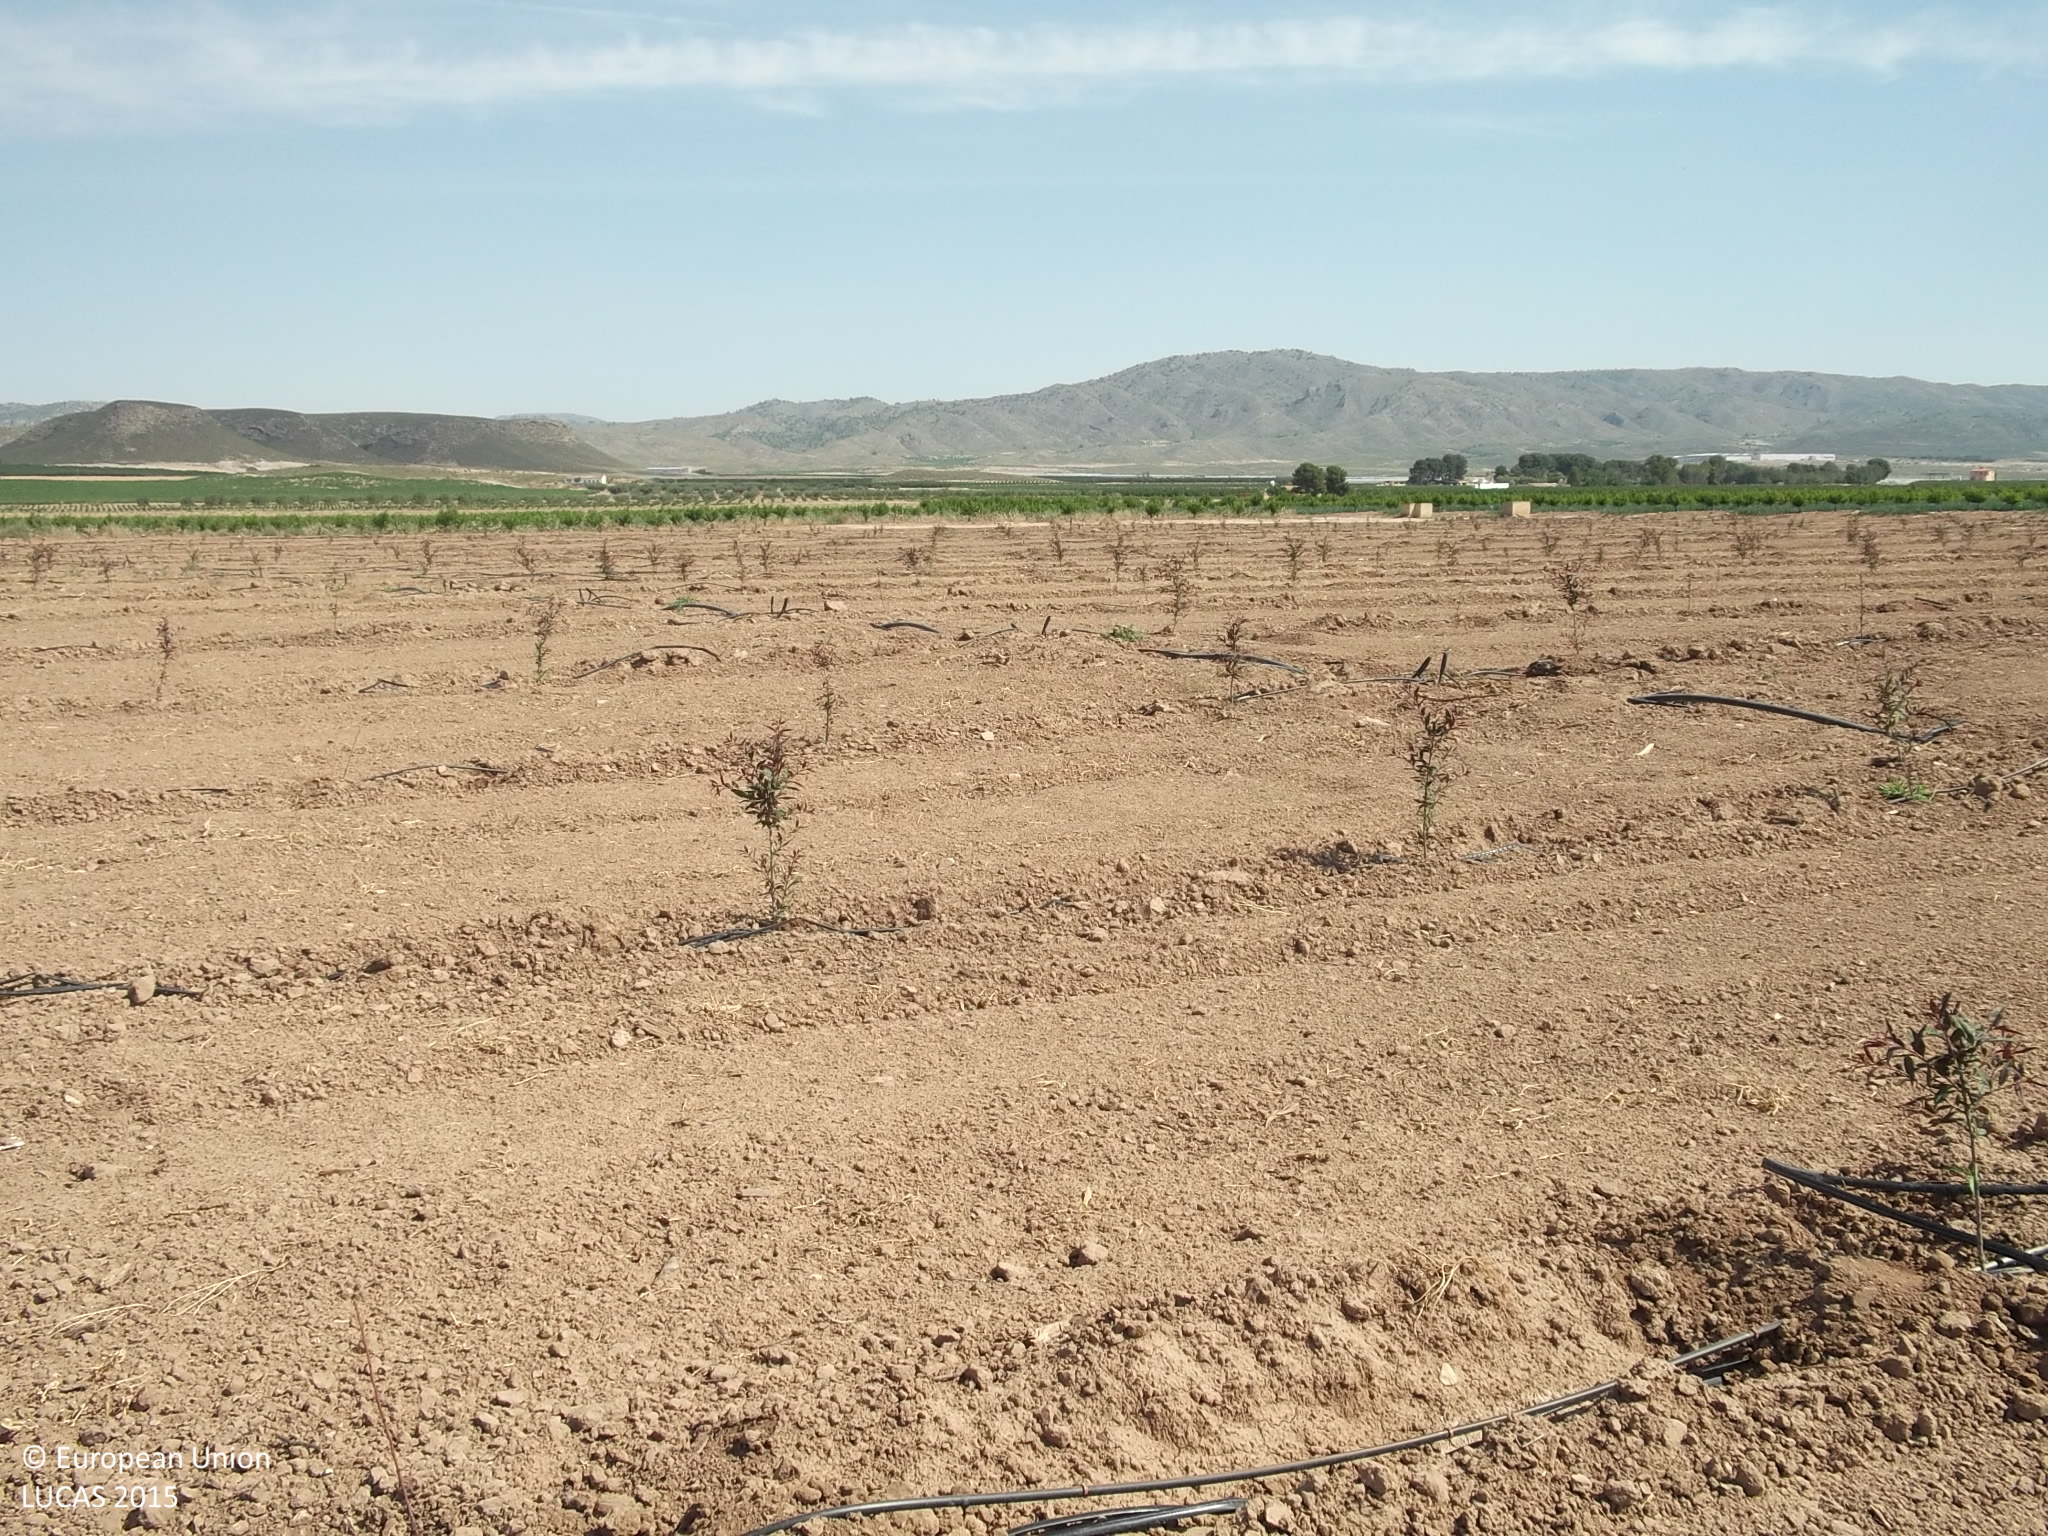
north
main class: Cropland
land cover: Other fruit trees and berries
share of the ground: < 10 %
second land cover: Other bare soil
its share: > 75 %
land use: Agriculture (excluding fallow land and kitchen gardens)
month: June
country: ES
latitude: 38.3736
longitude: -1.4250
